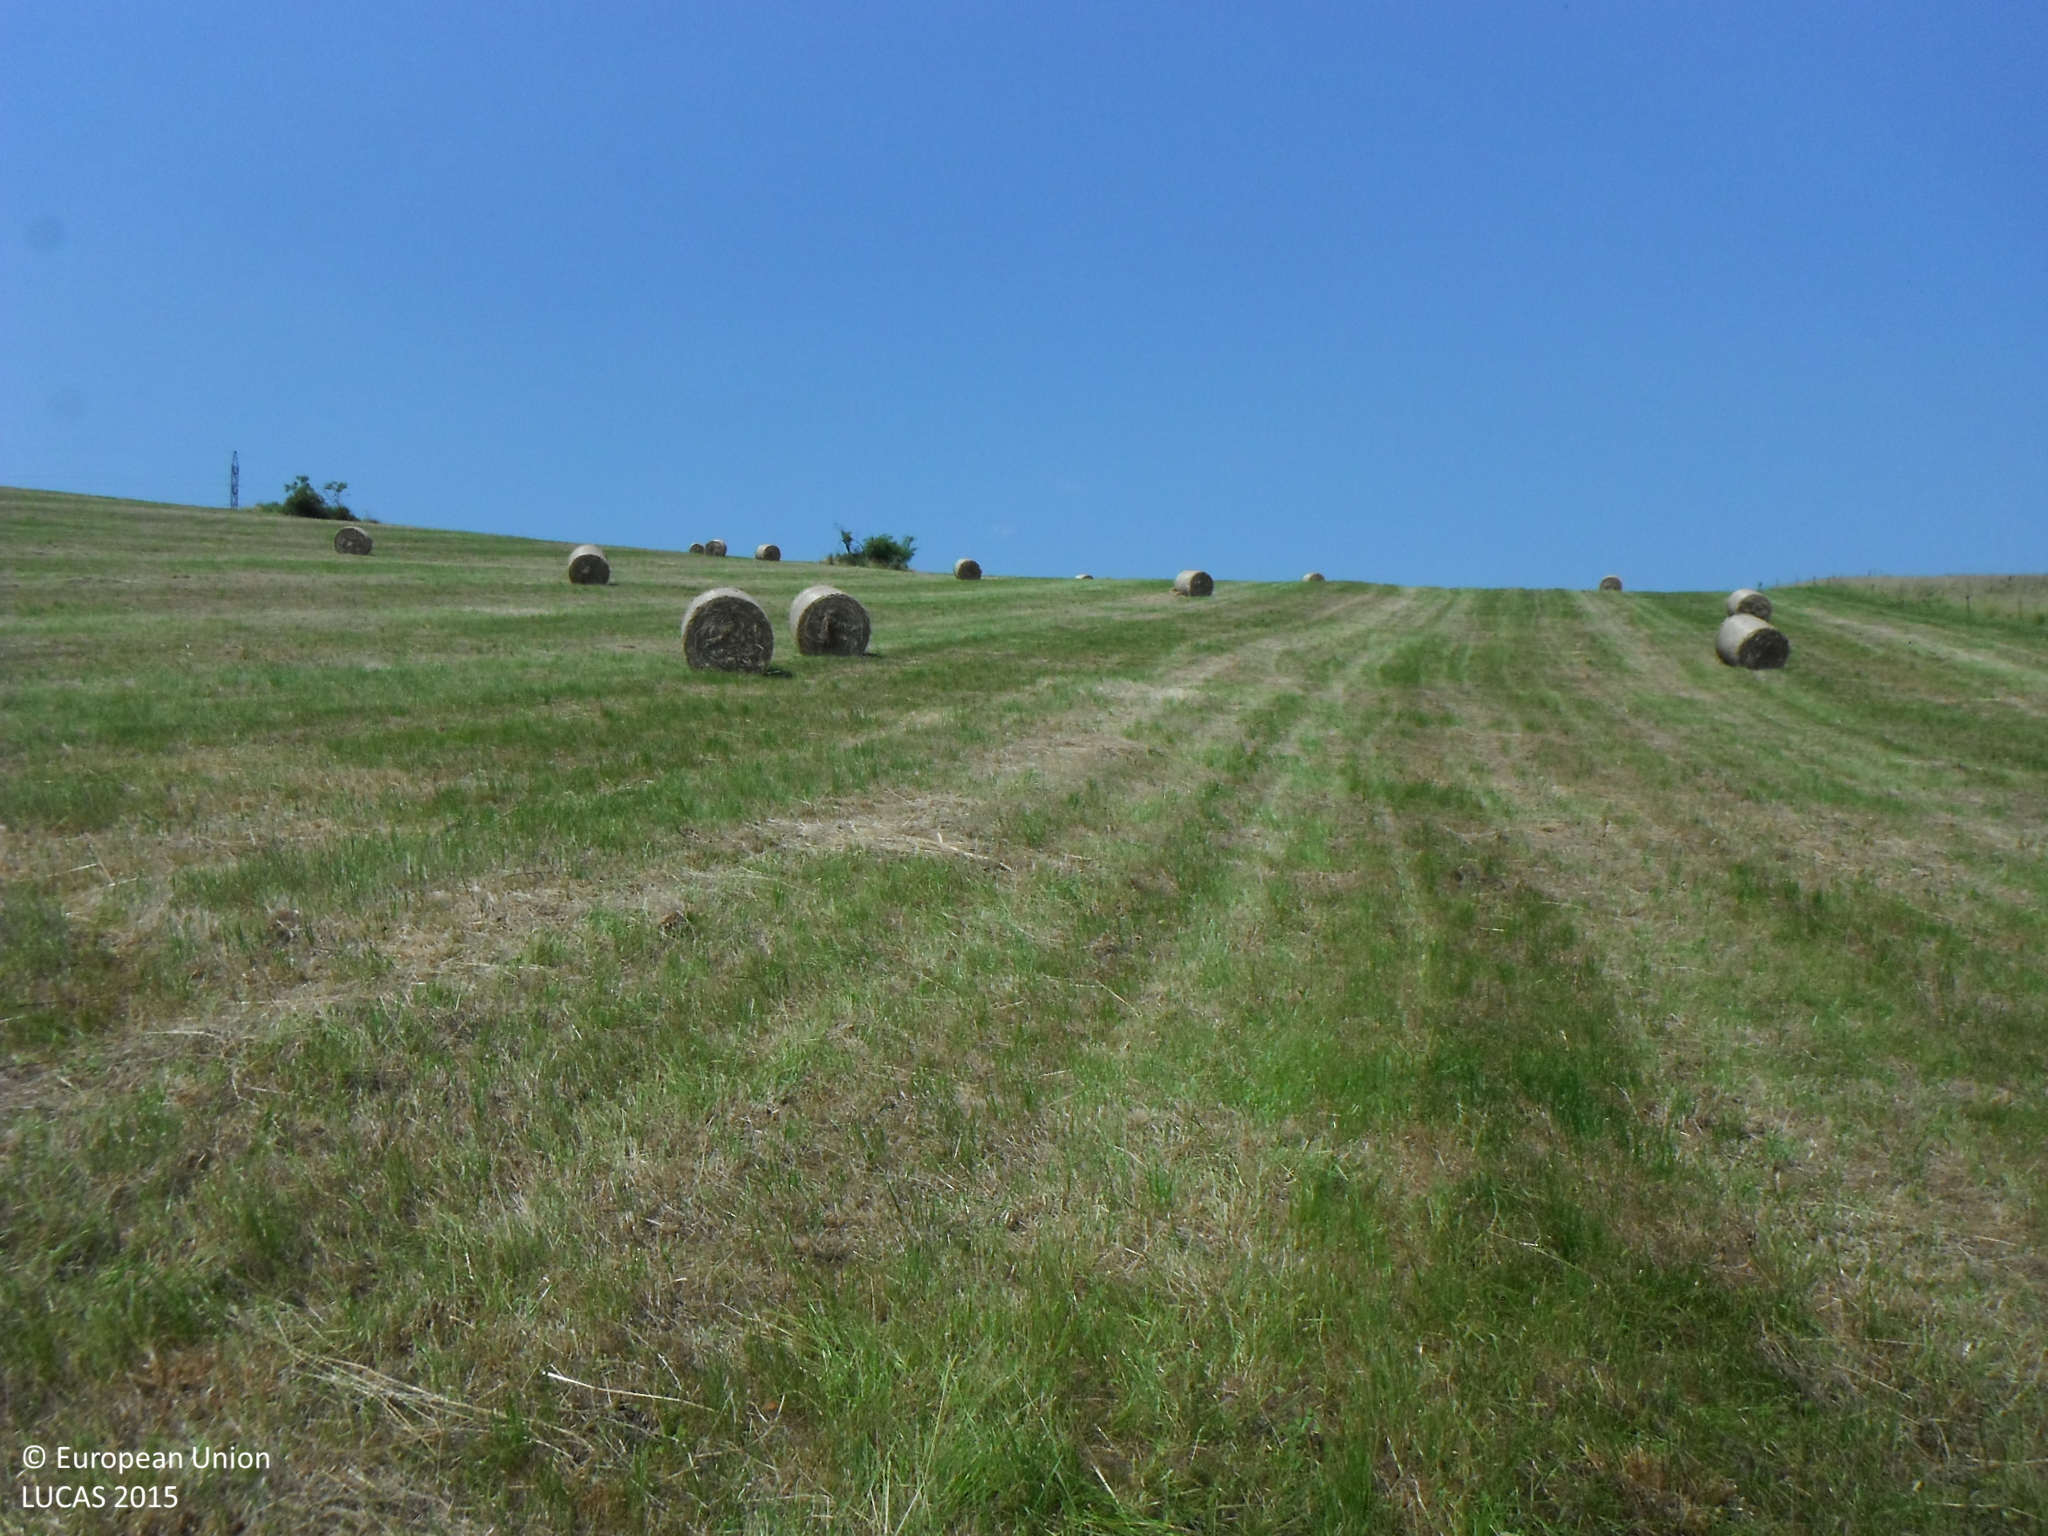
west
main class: Grassland
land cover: Grassland without tree/shrub cover
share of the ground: > 75 %
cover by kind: herbaceous plants 100 %
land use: Agriculture (excluding fallow land and kitchen gardens)
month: July
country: SK
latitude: 49.1504
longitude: 20.9135
